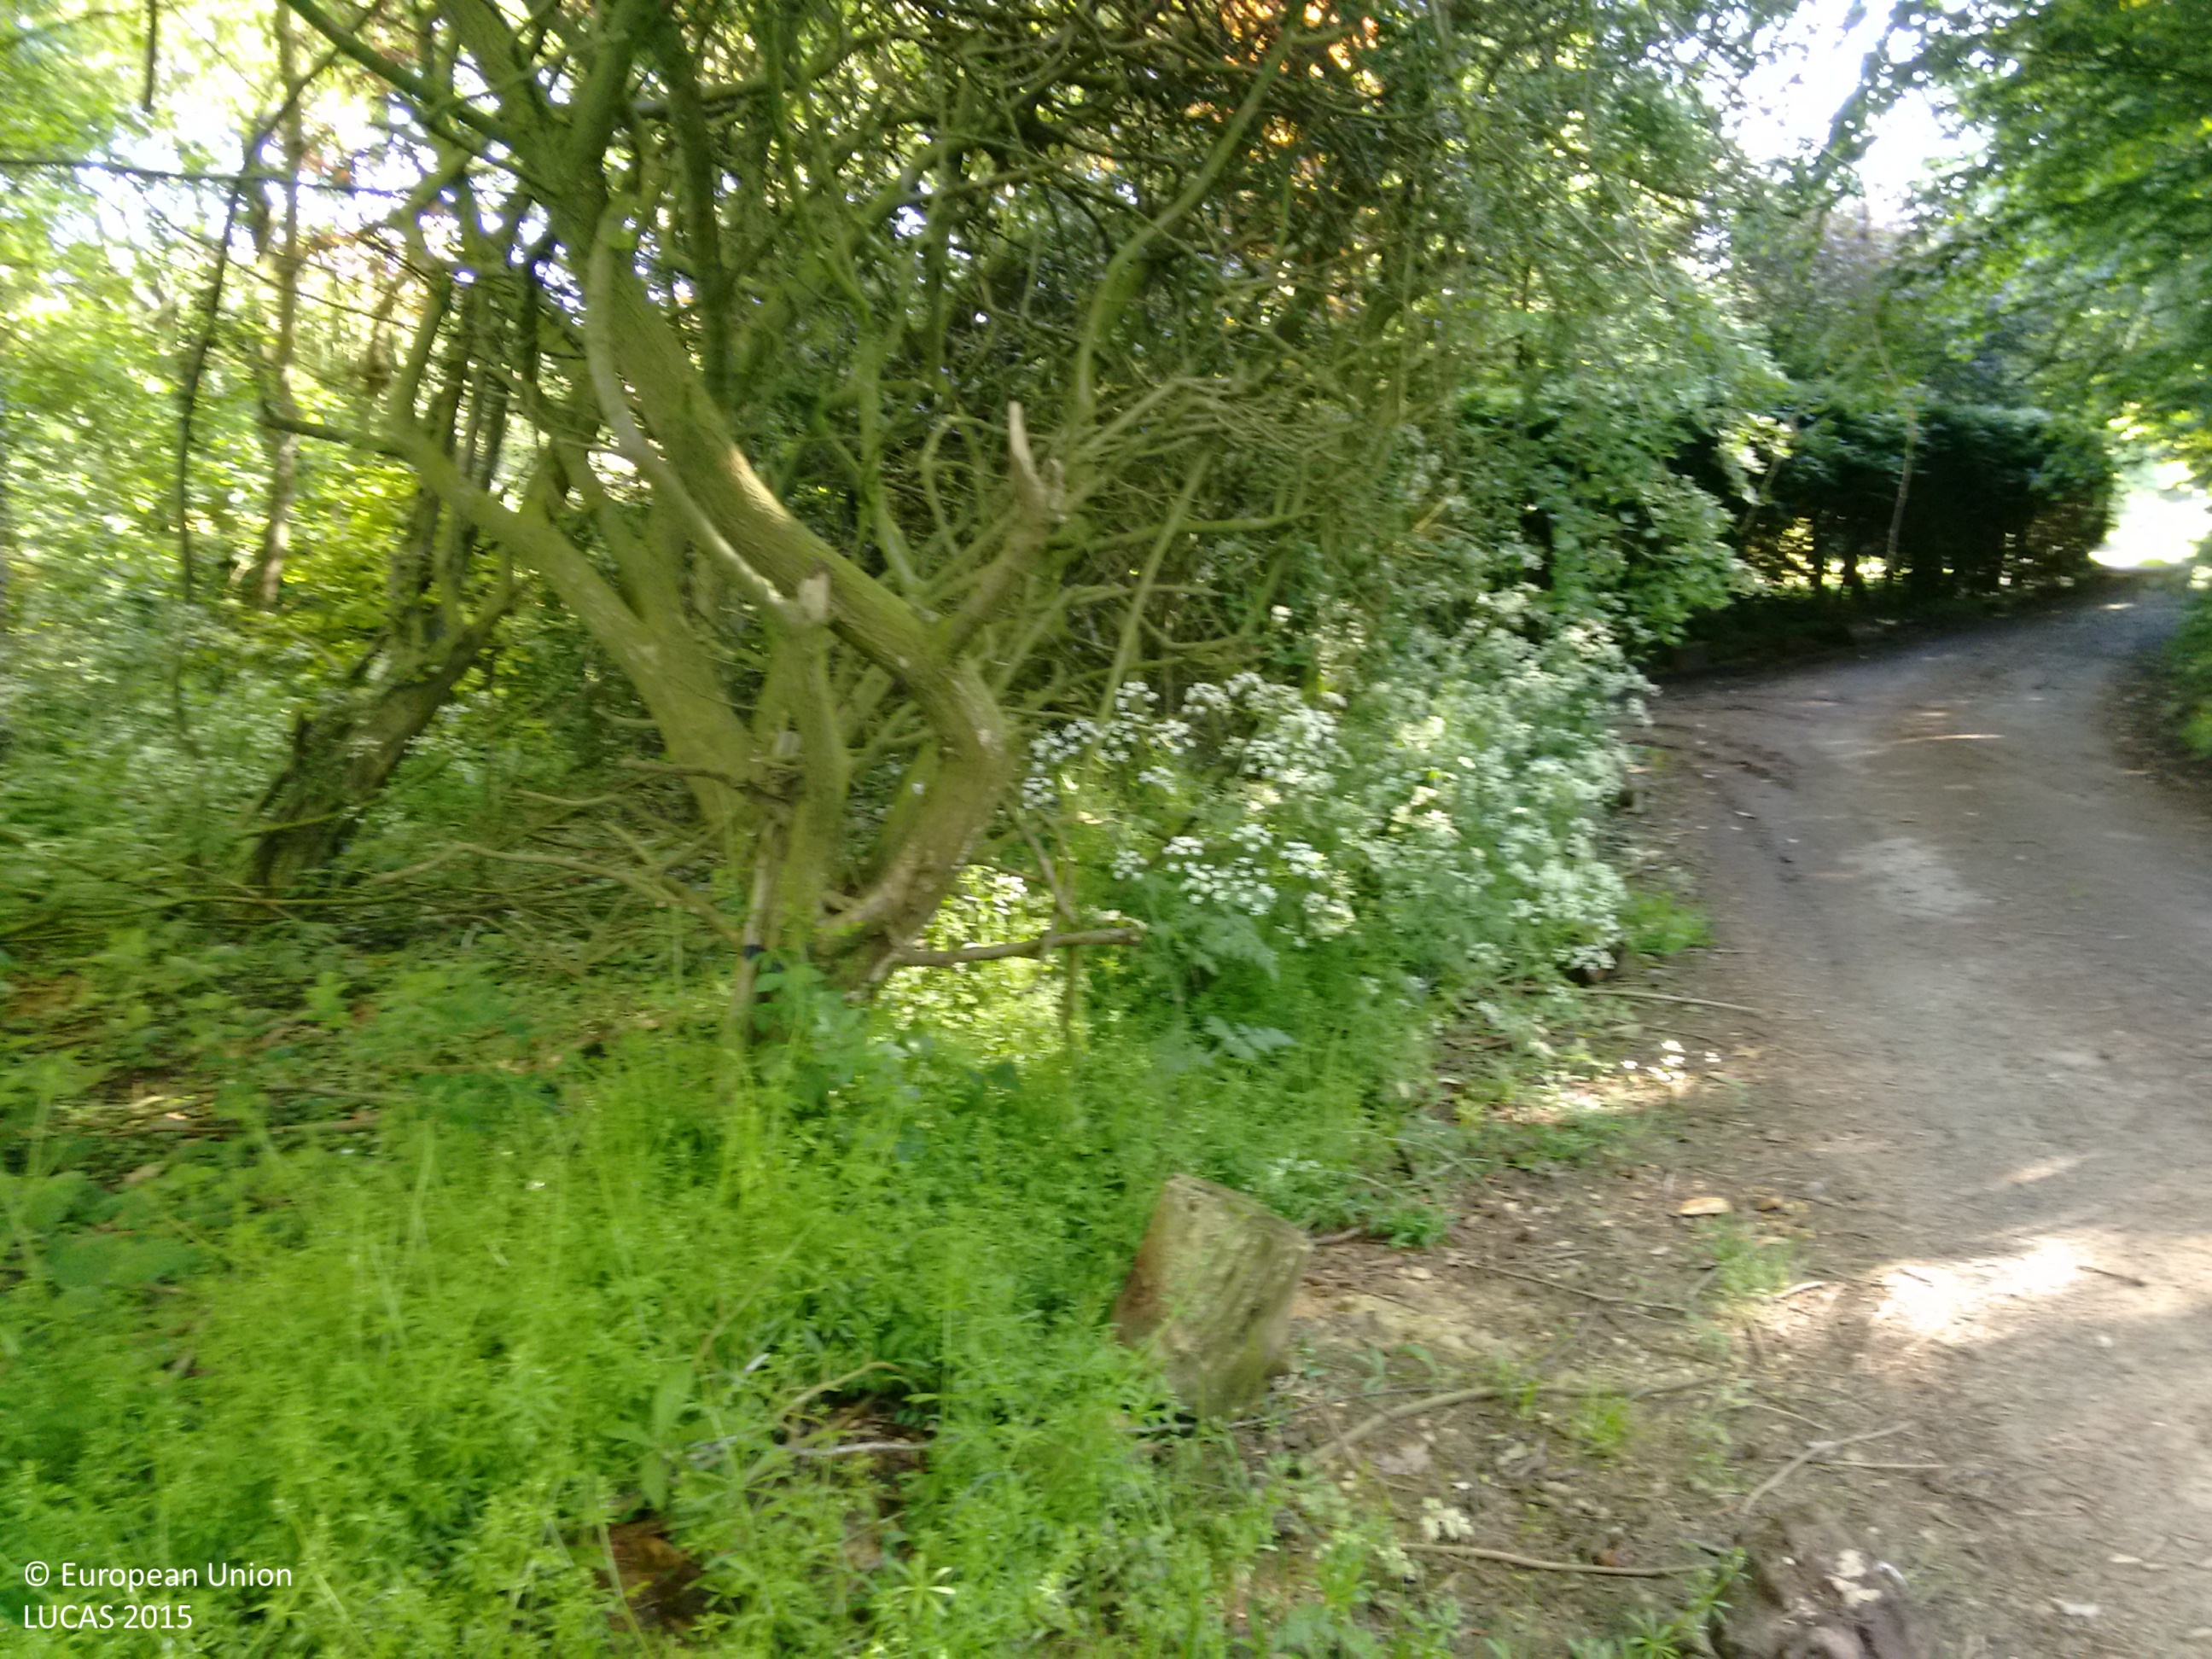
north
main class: Woodland
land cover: Broadleaved woodland
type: mesophytic deciduous forest
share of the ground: > 75 %
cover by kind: broadleaved forest trees 90 %, shrubs 10 %
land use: Amenities, museums, leisure
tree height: > 5 m
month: May
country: GB
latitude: 51.1649
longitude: 1.2121
